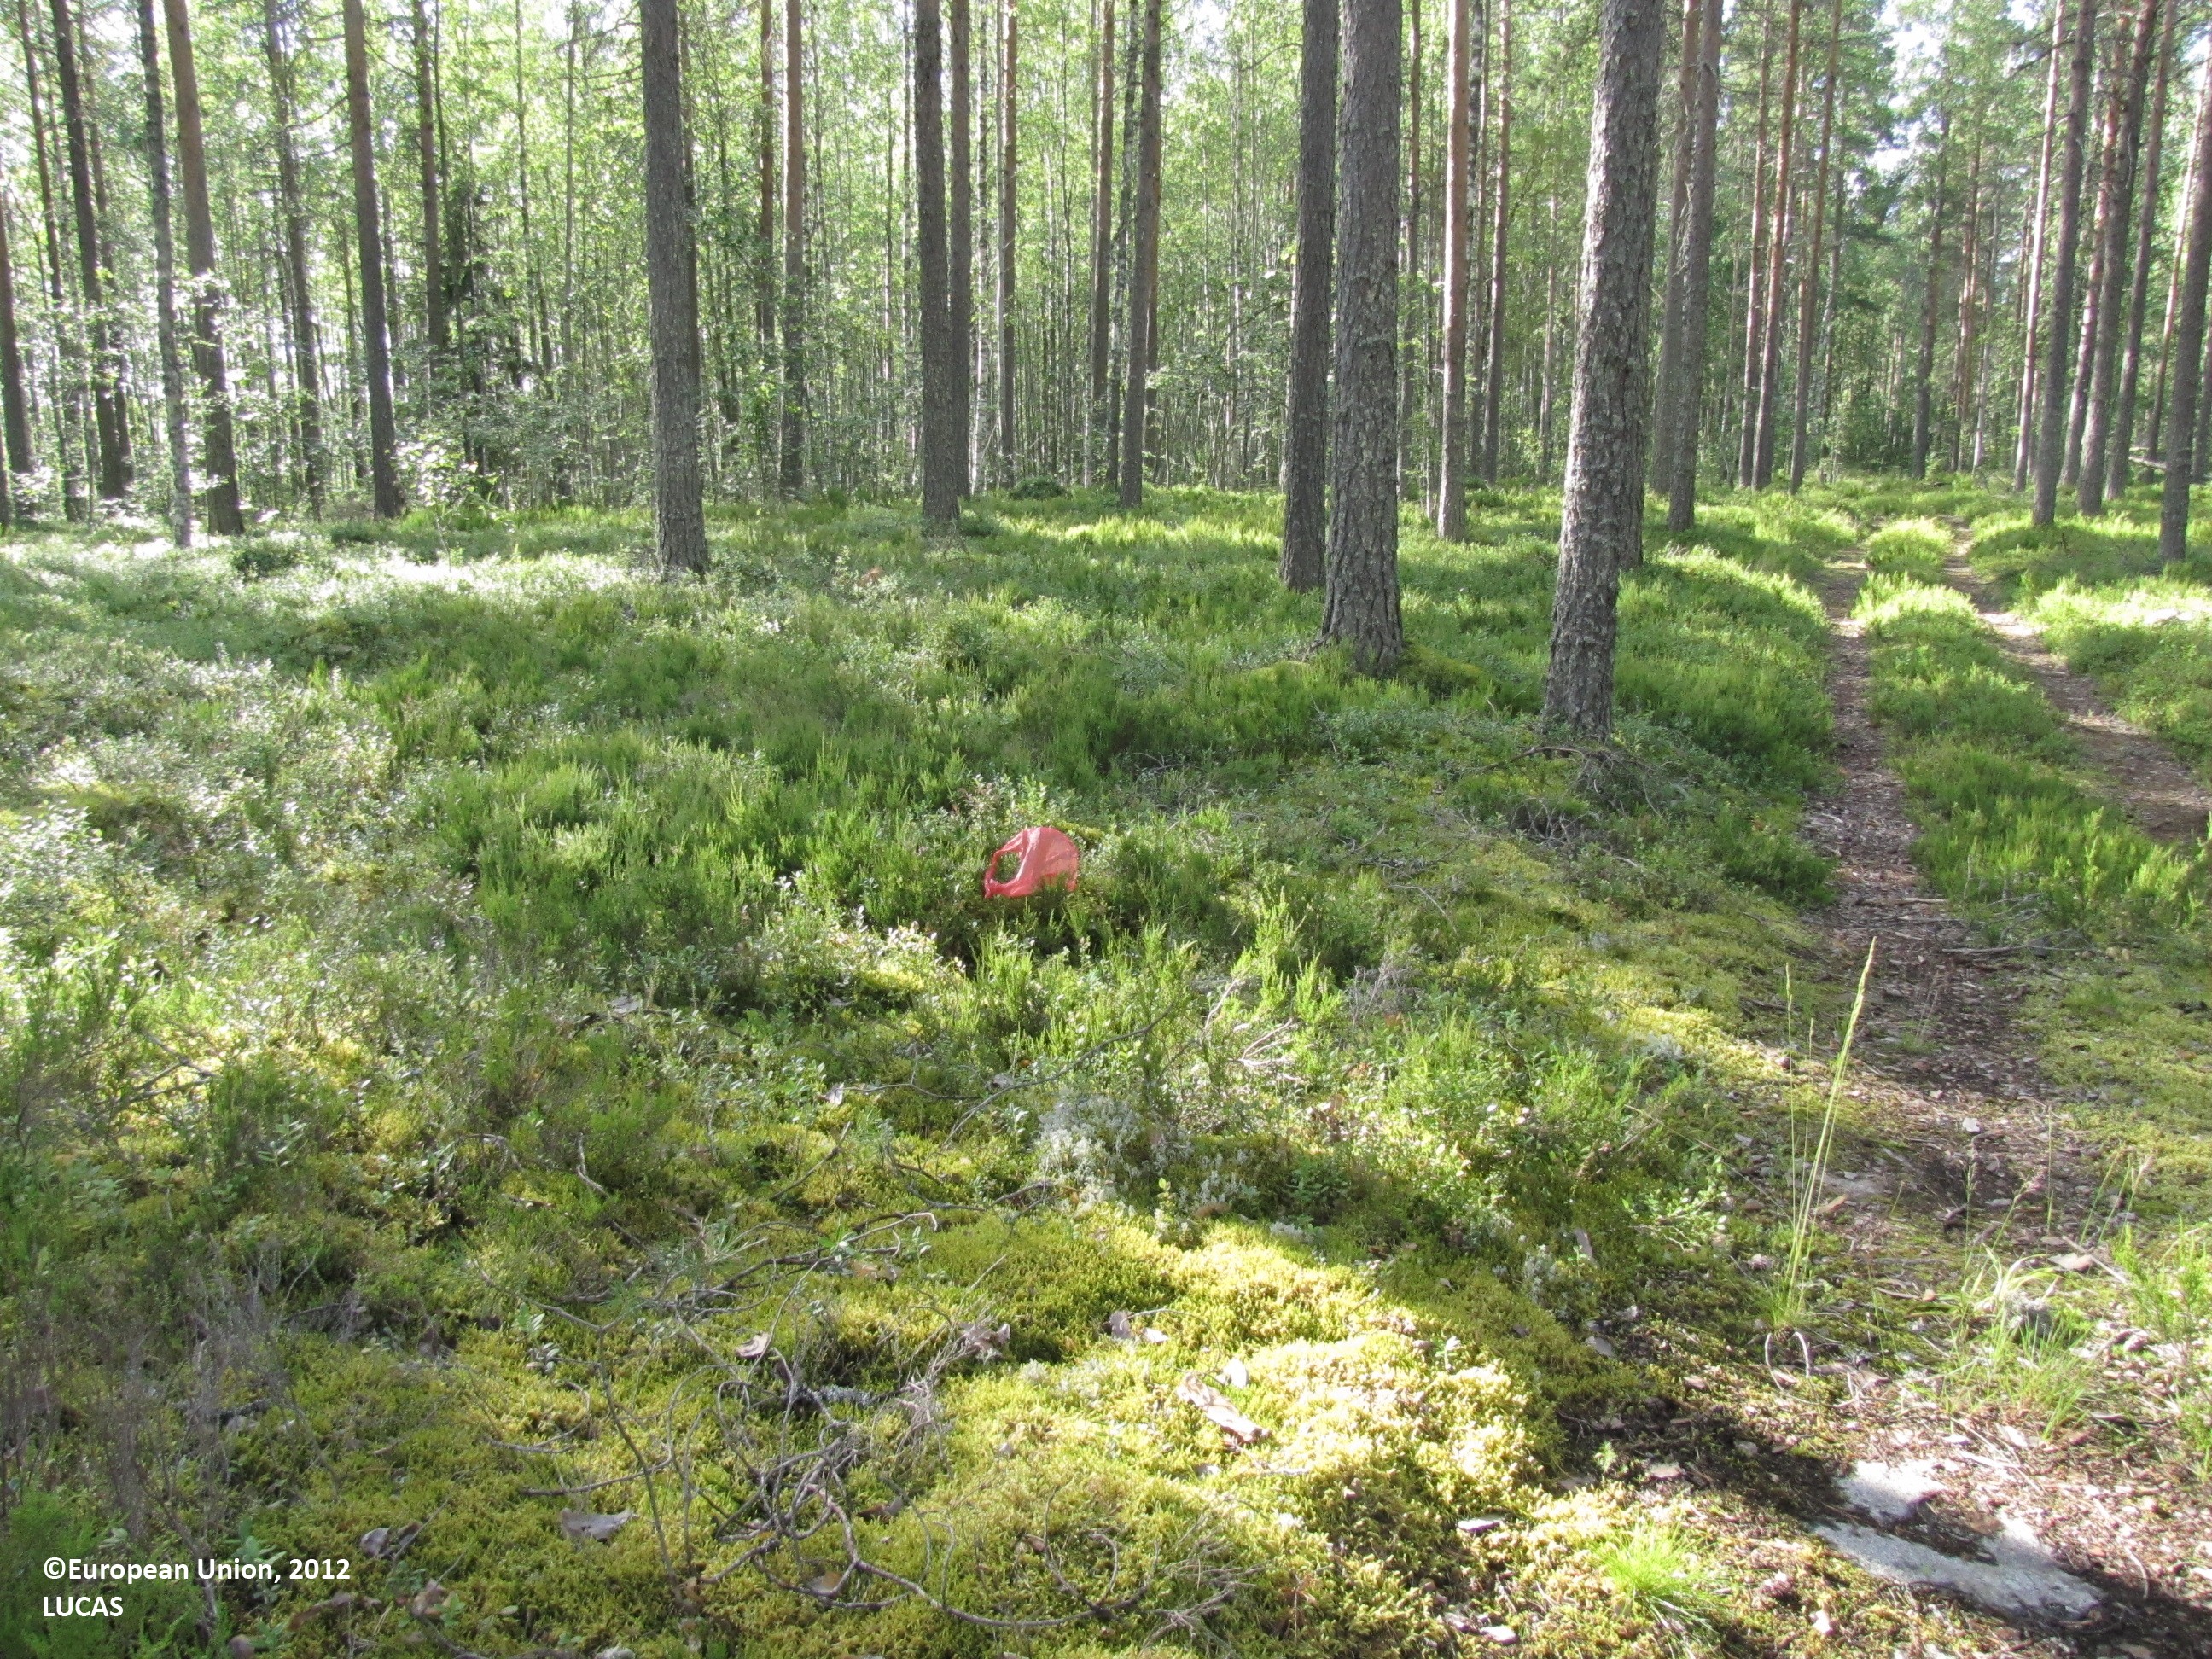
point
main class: Woodland
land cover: Pine dominated coniferous woodland
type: boreal forest
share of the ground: > 75 %
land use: Forestry
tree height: > 5 m
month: July
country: FI
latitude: 62.3625
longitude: 23.1486
